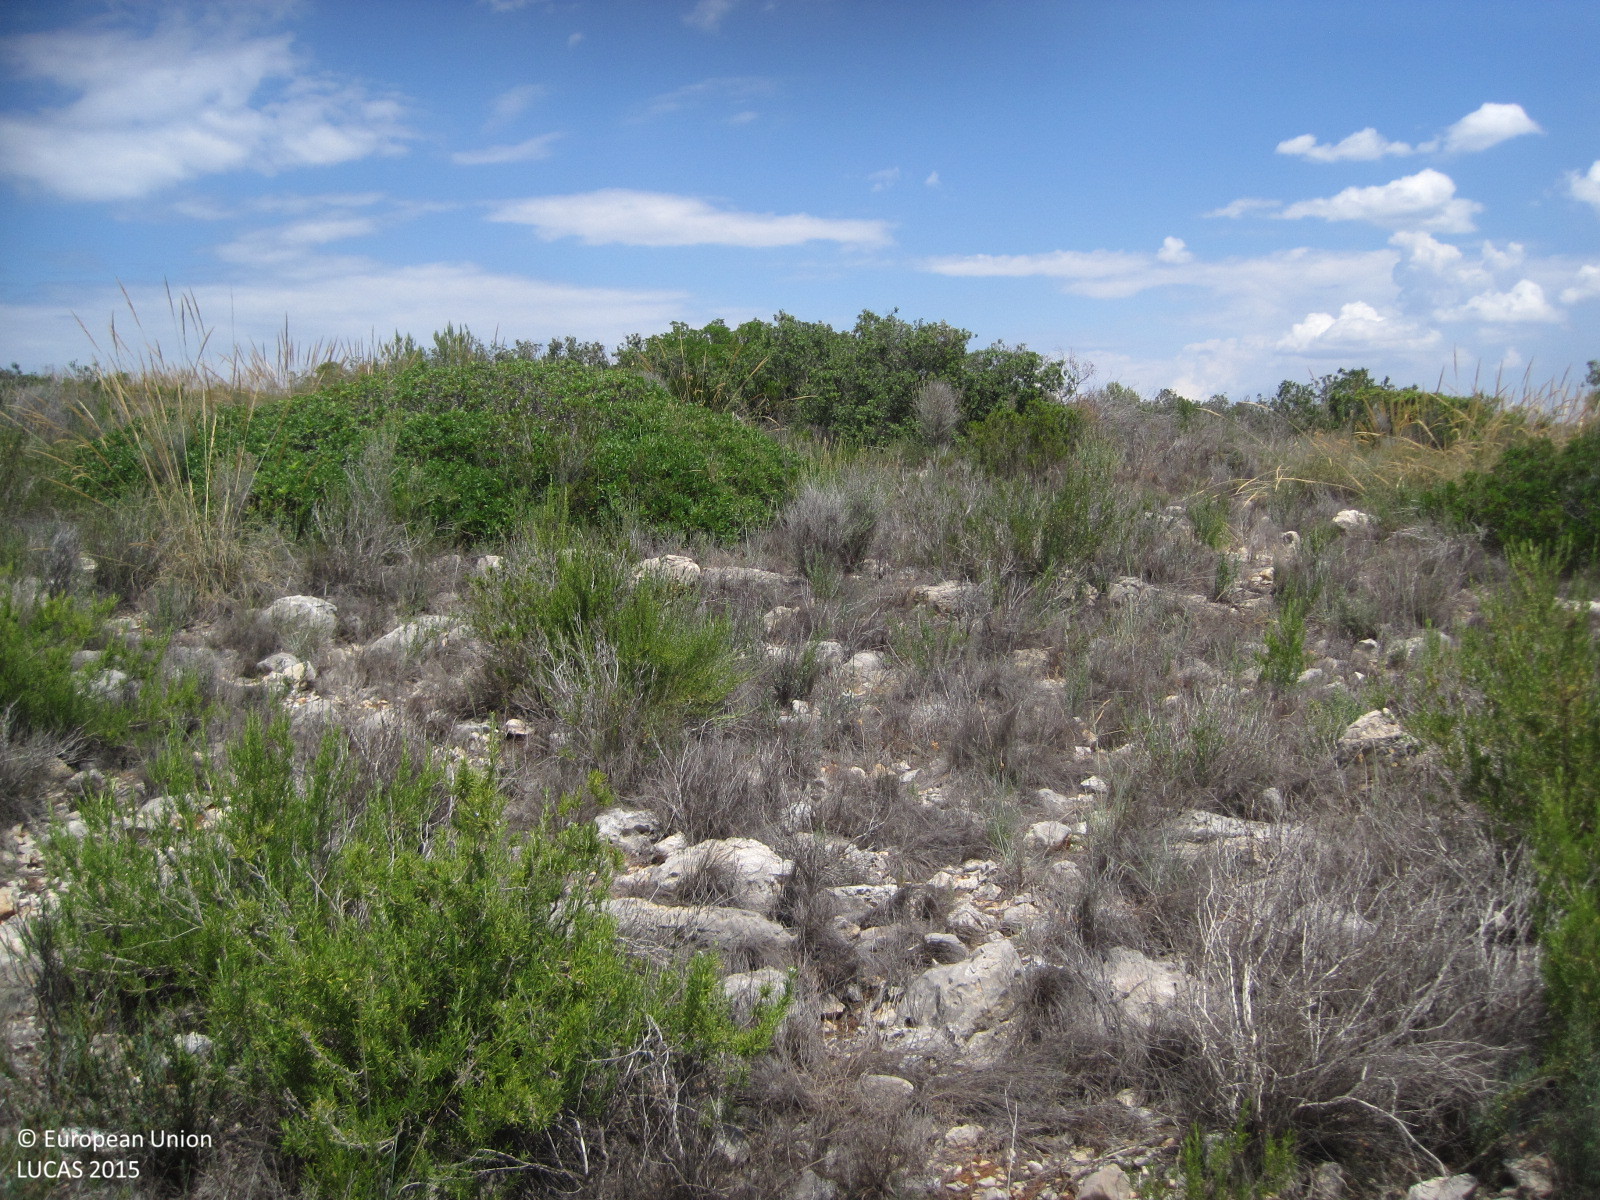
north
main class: Shrubland
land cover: Shrubland without tree cover
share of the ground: 25 - 50 %
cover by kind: shrubs 40 %, herbaceous plants 30 %, consolidated bare surface 30 %
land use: Semi-natural and natural areas not in use
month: June
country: ES
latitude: 39.2000
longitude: -0.5904
